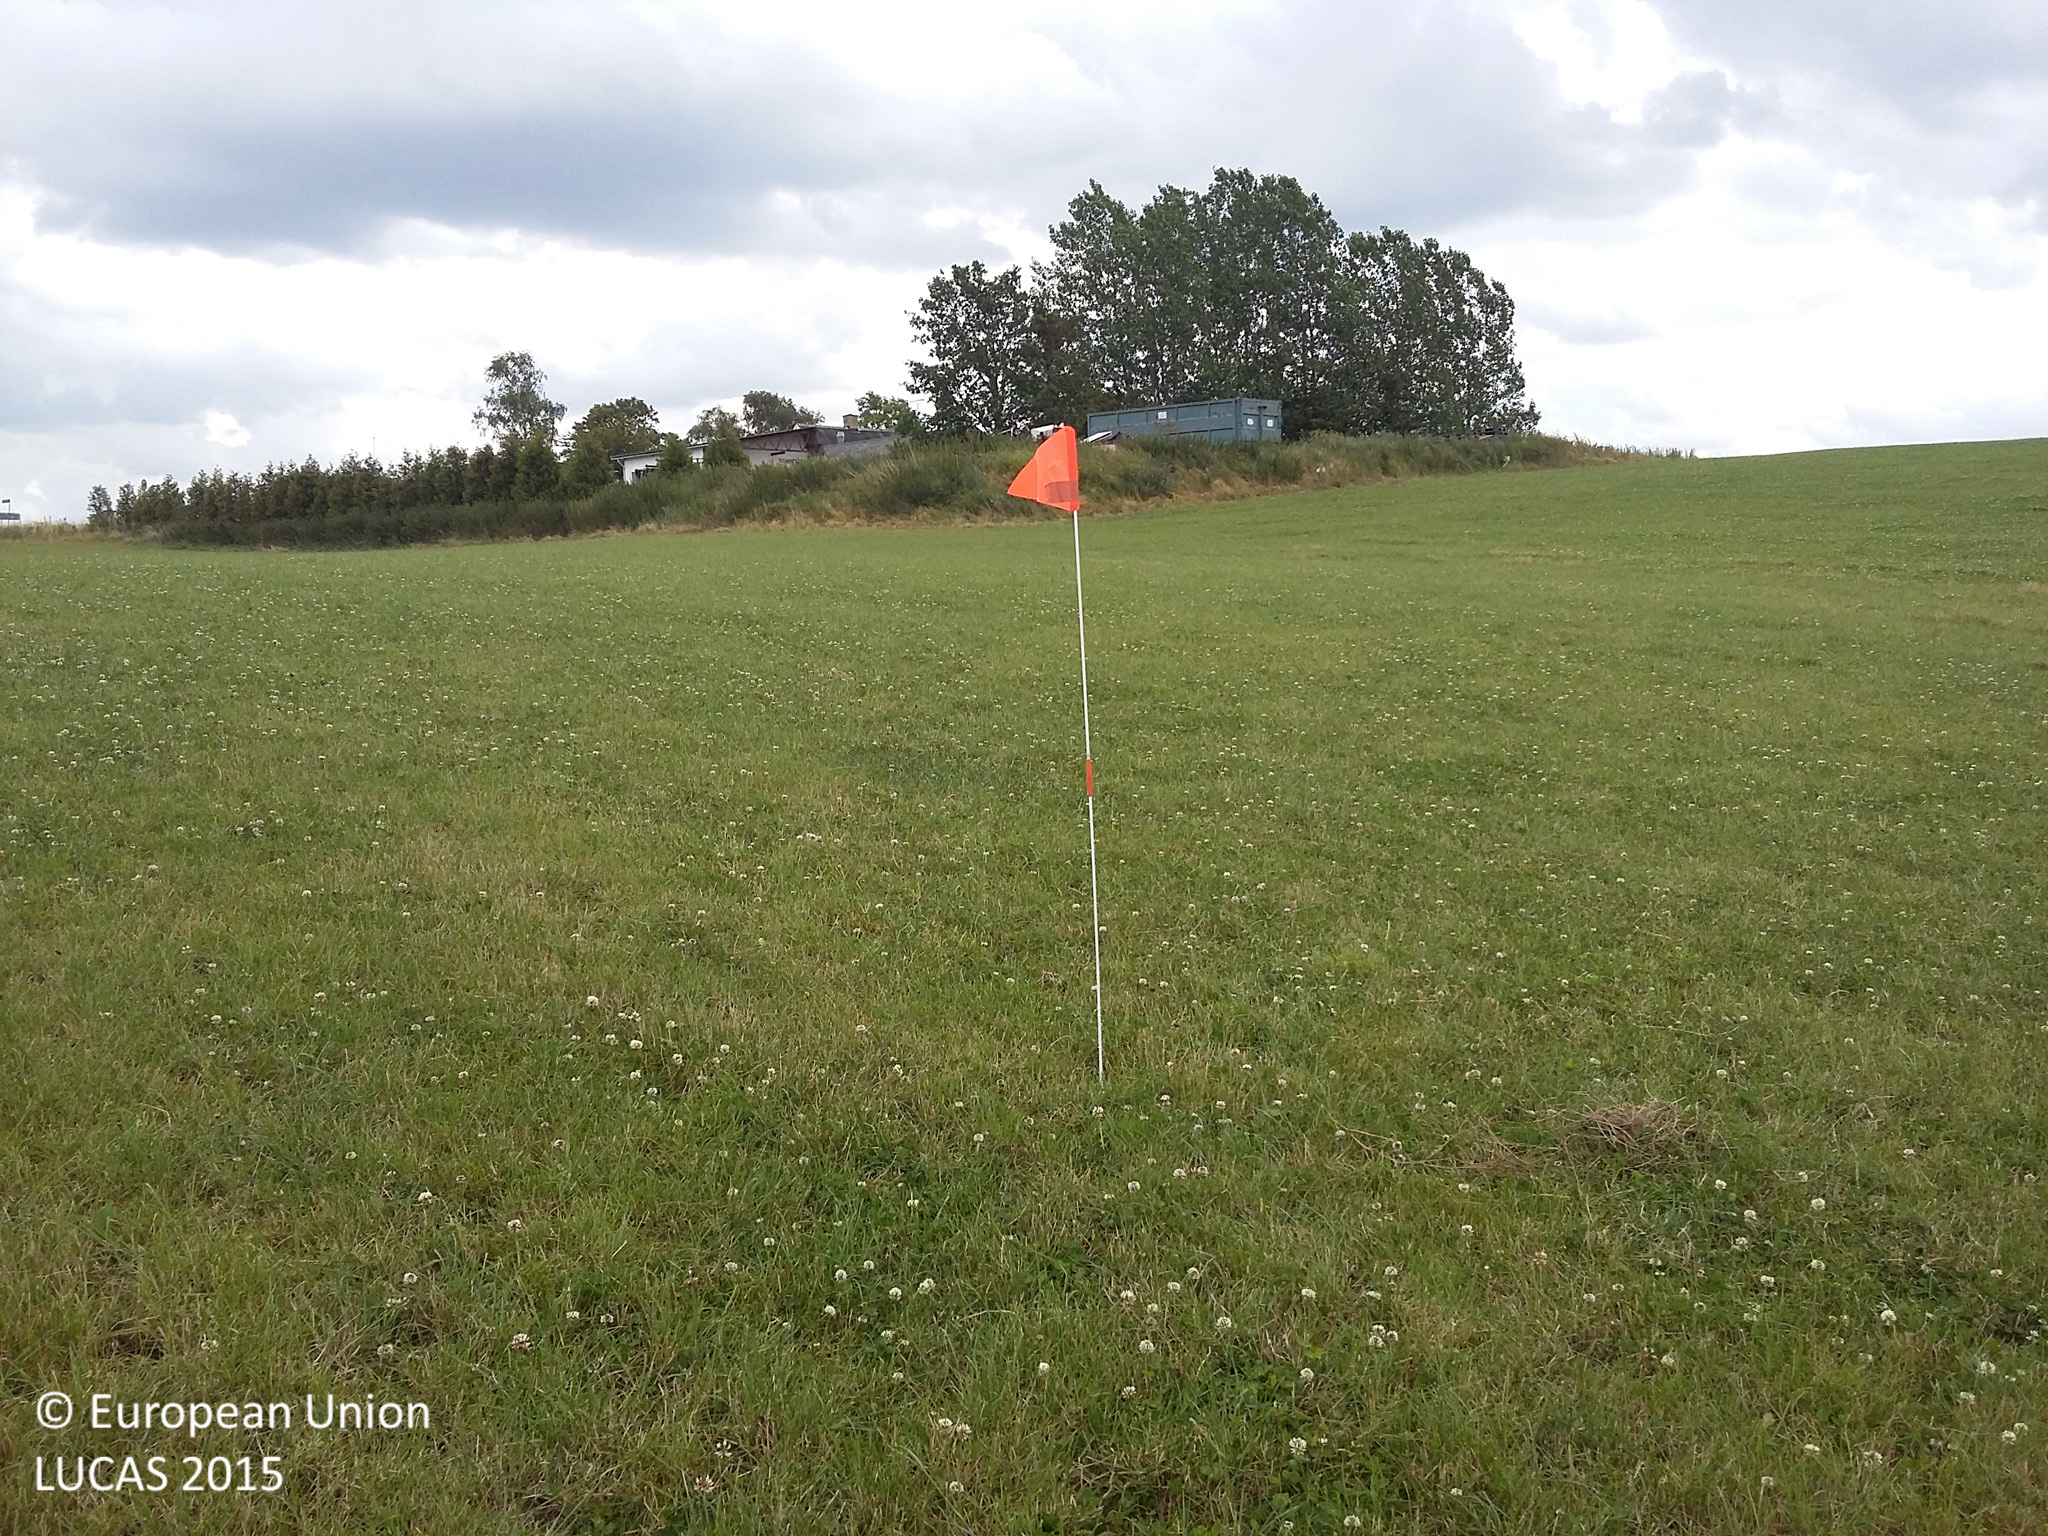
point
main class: Grassland
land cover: Grassland without tree/shrub cover
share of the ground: > 75 %
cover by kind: herbaceous plants 100 %
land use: Agriculture (excluding fallow land and kitchen gardens)
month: July
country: DK
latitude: 55.7418
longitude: 11.9256
